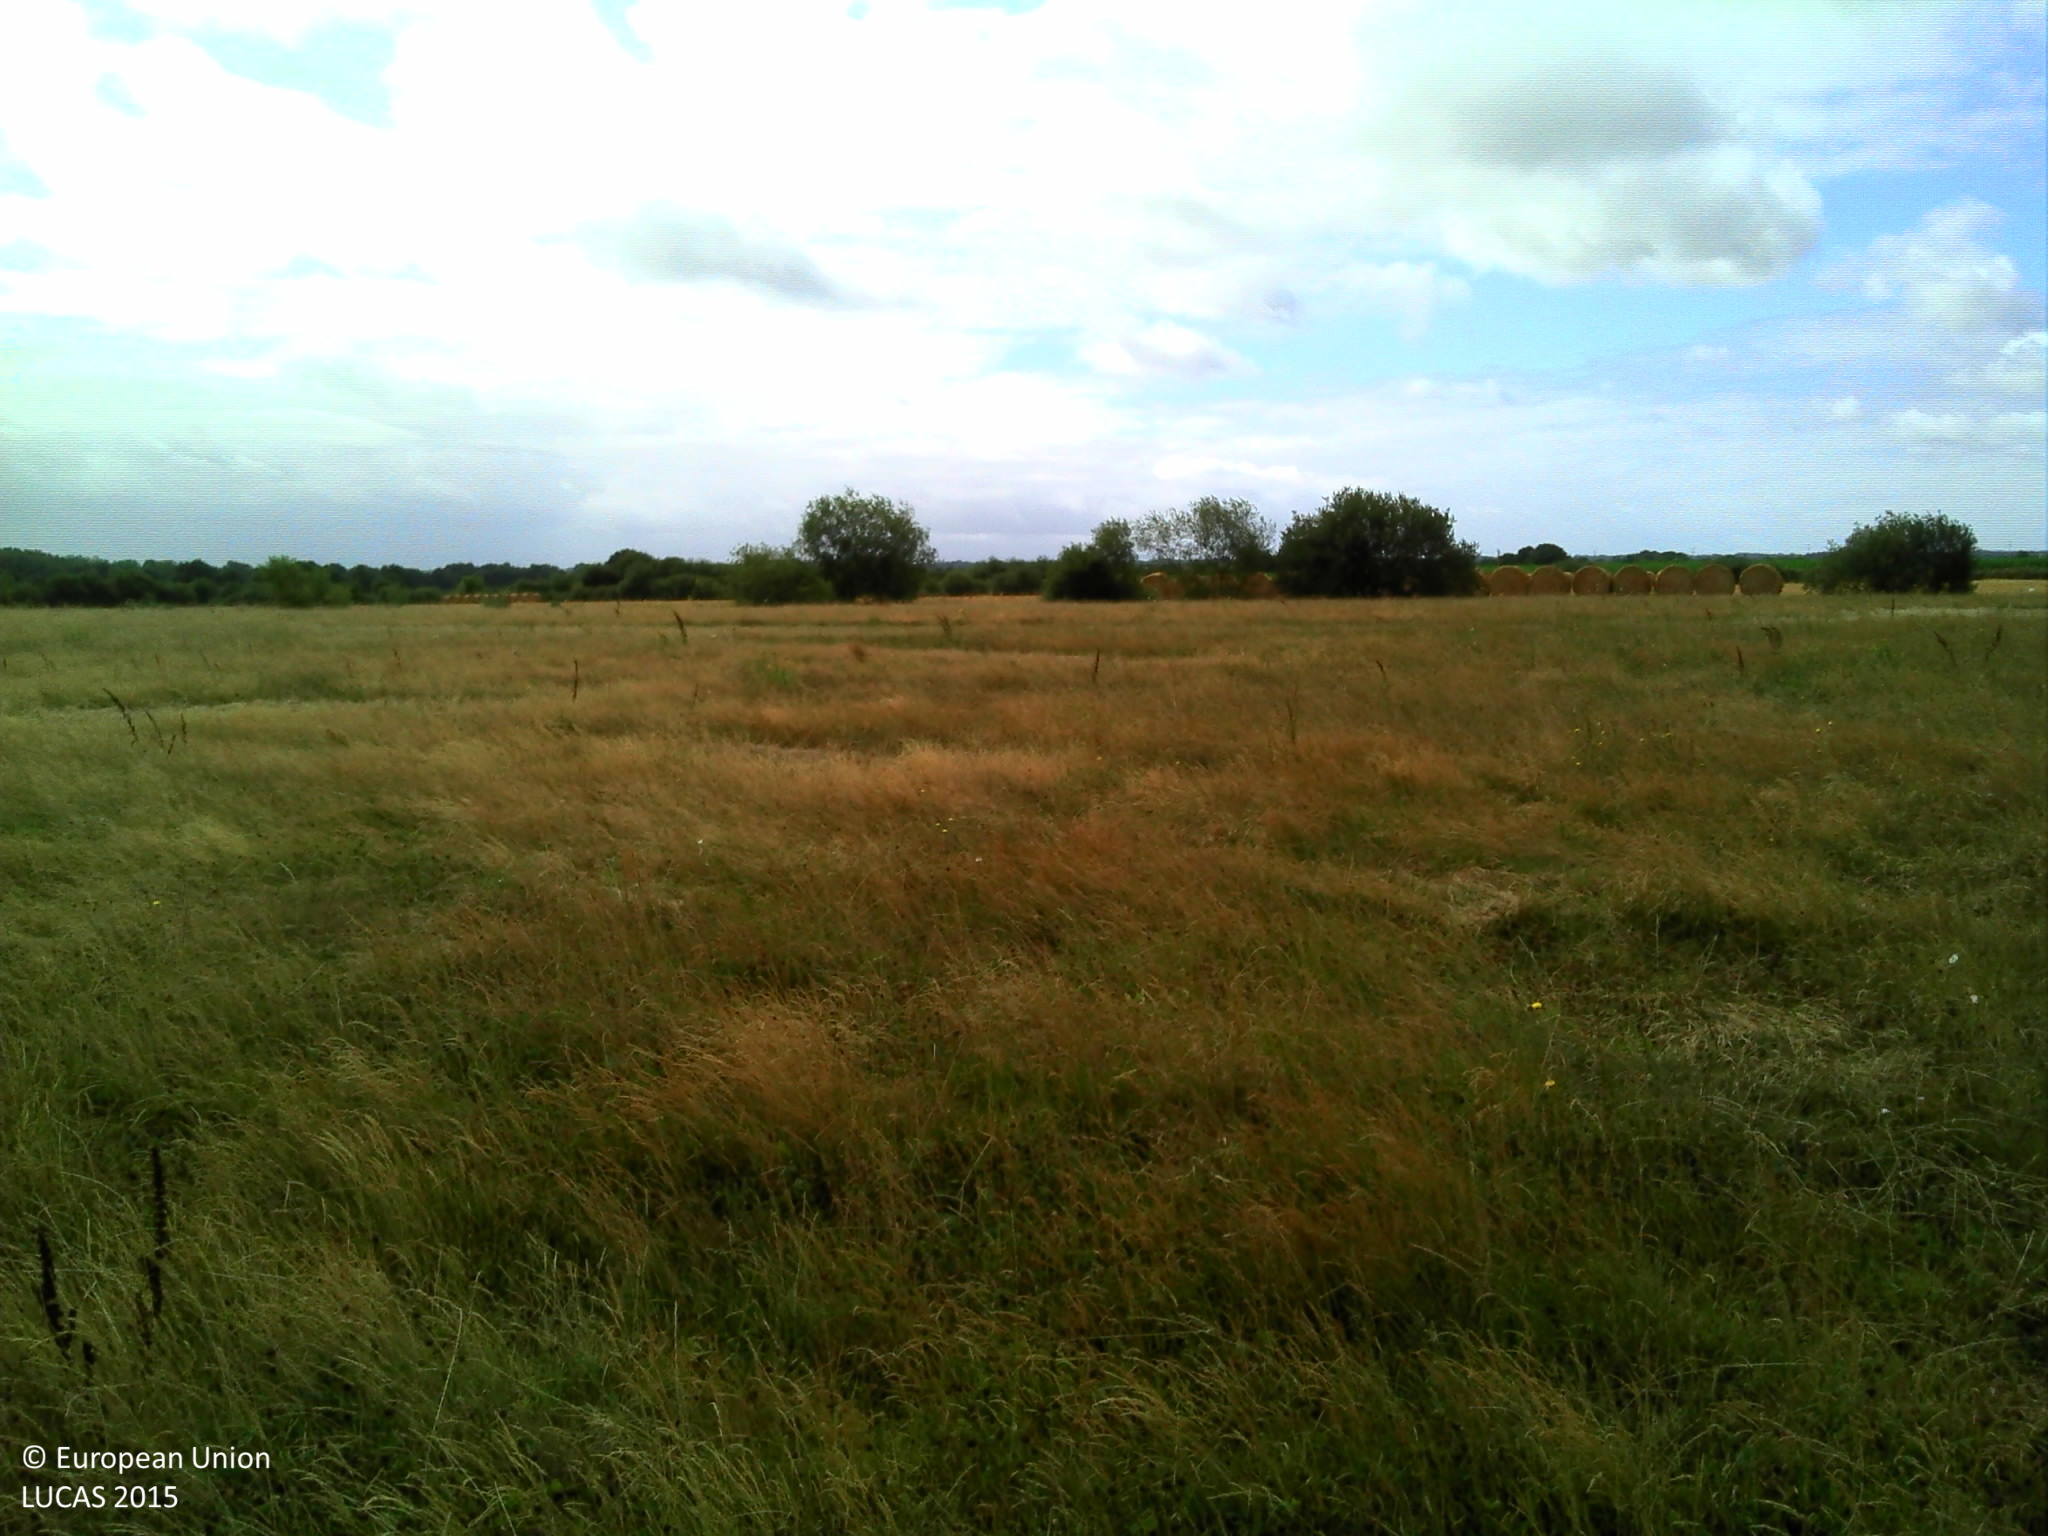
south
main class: Cropland
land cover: Temporary grasslands
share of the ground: > 75 %
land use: Agriculture (excluding fallow land and kitchen gardens)
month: July
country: FR
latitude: 47.4500
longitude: -1.8914
